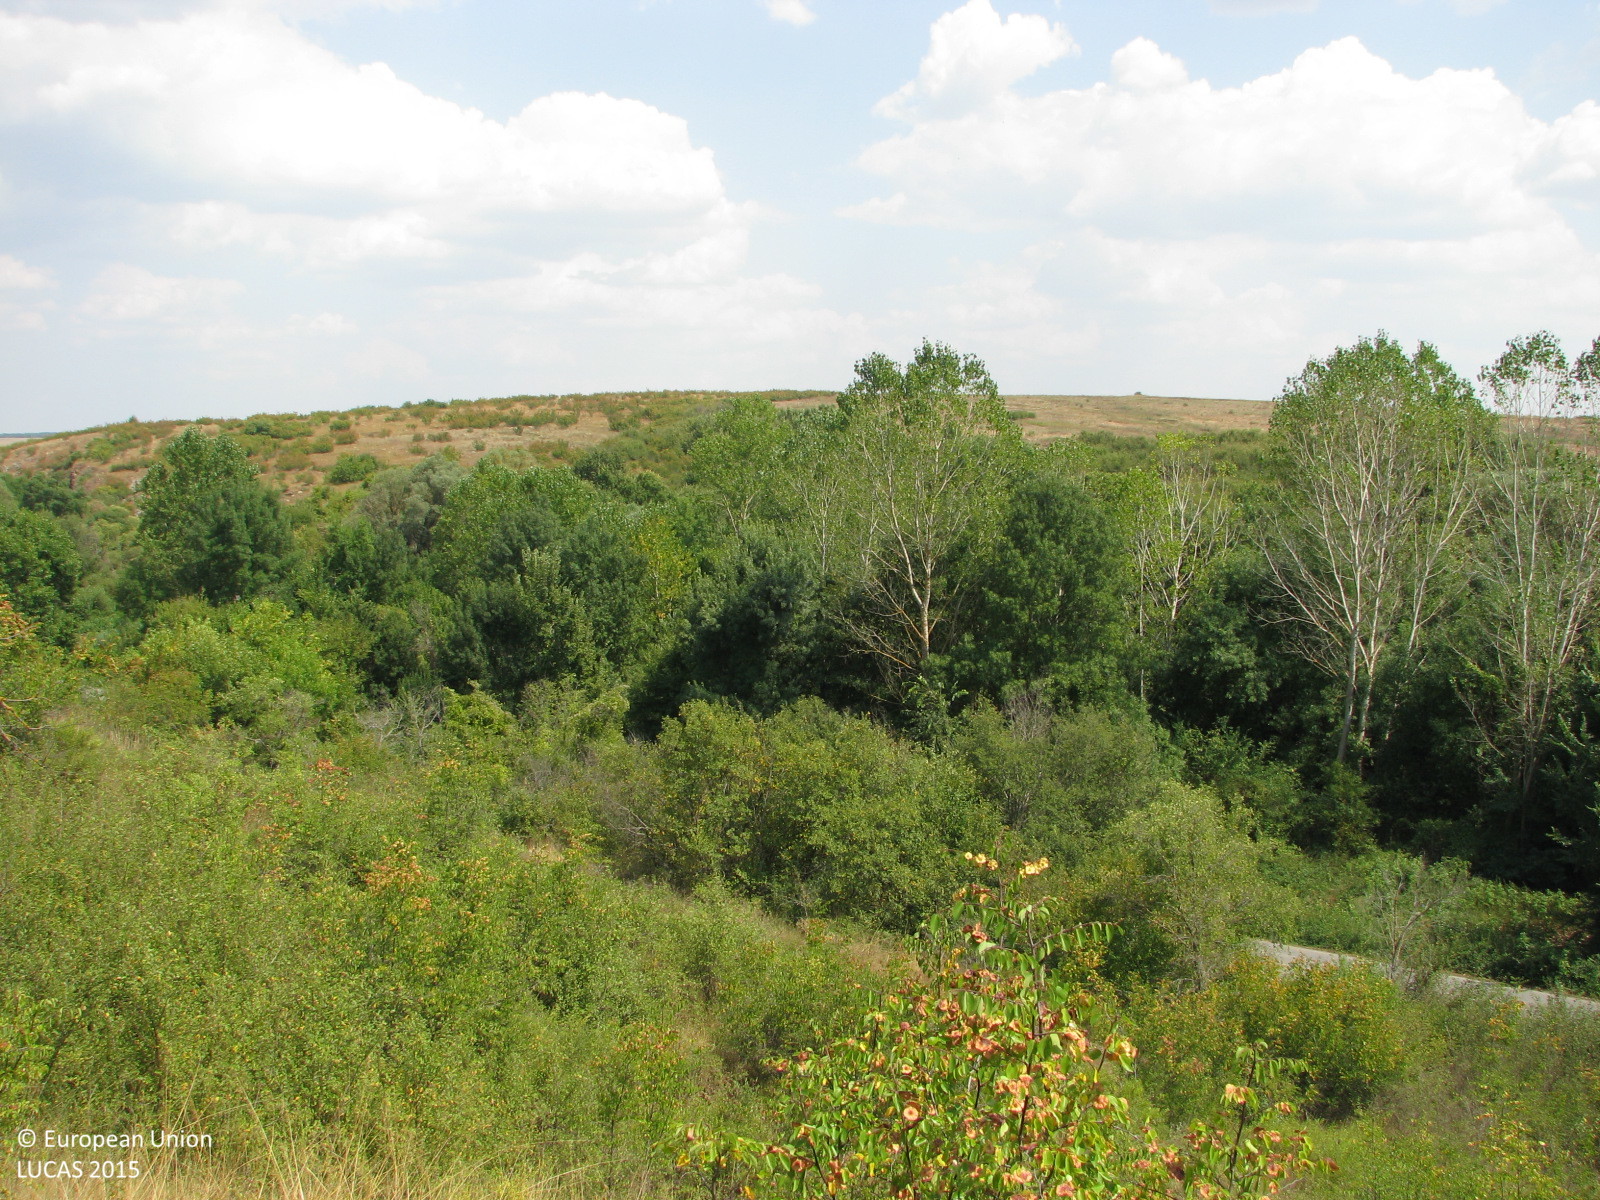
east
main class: Shrubland
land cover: Shrubland with sparse tree cover
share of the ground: 50 - 75 %
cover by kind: shrubs 50 %, herbaceous plants 45 %, broadleaved forest trees 5 %
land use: Agriculture (excluding fallow land and kitchen gardens)
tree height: < 5 m
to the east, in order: Shrubland with sparse tree cover; Grassland with sparse tree/shrub cover; Shrubland with sparse tree cover; Paved roads, cycling and walking lanes; Shrubland with sparse tree cover; Ditches and canals; Broadleaved woodland; Tracks; Broadleaved woodland; Inland fresh running water; Artificial constructions; Shrubland with sparse tree cover; Broadleaved woodland
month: August
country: BG
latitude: 42.1777
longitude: 26.6907
